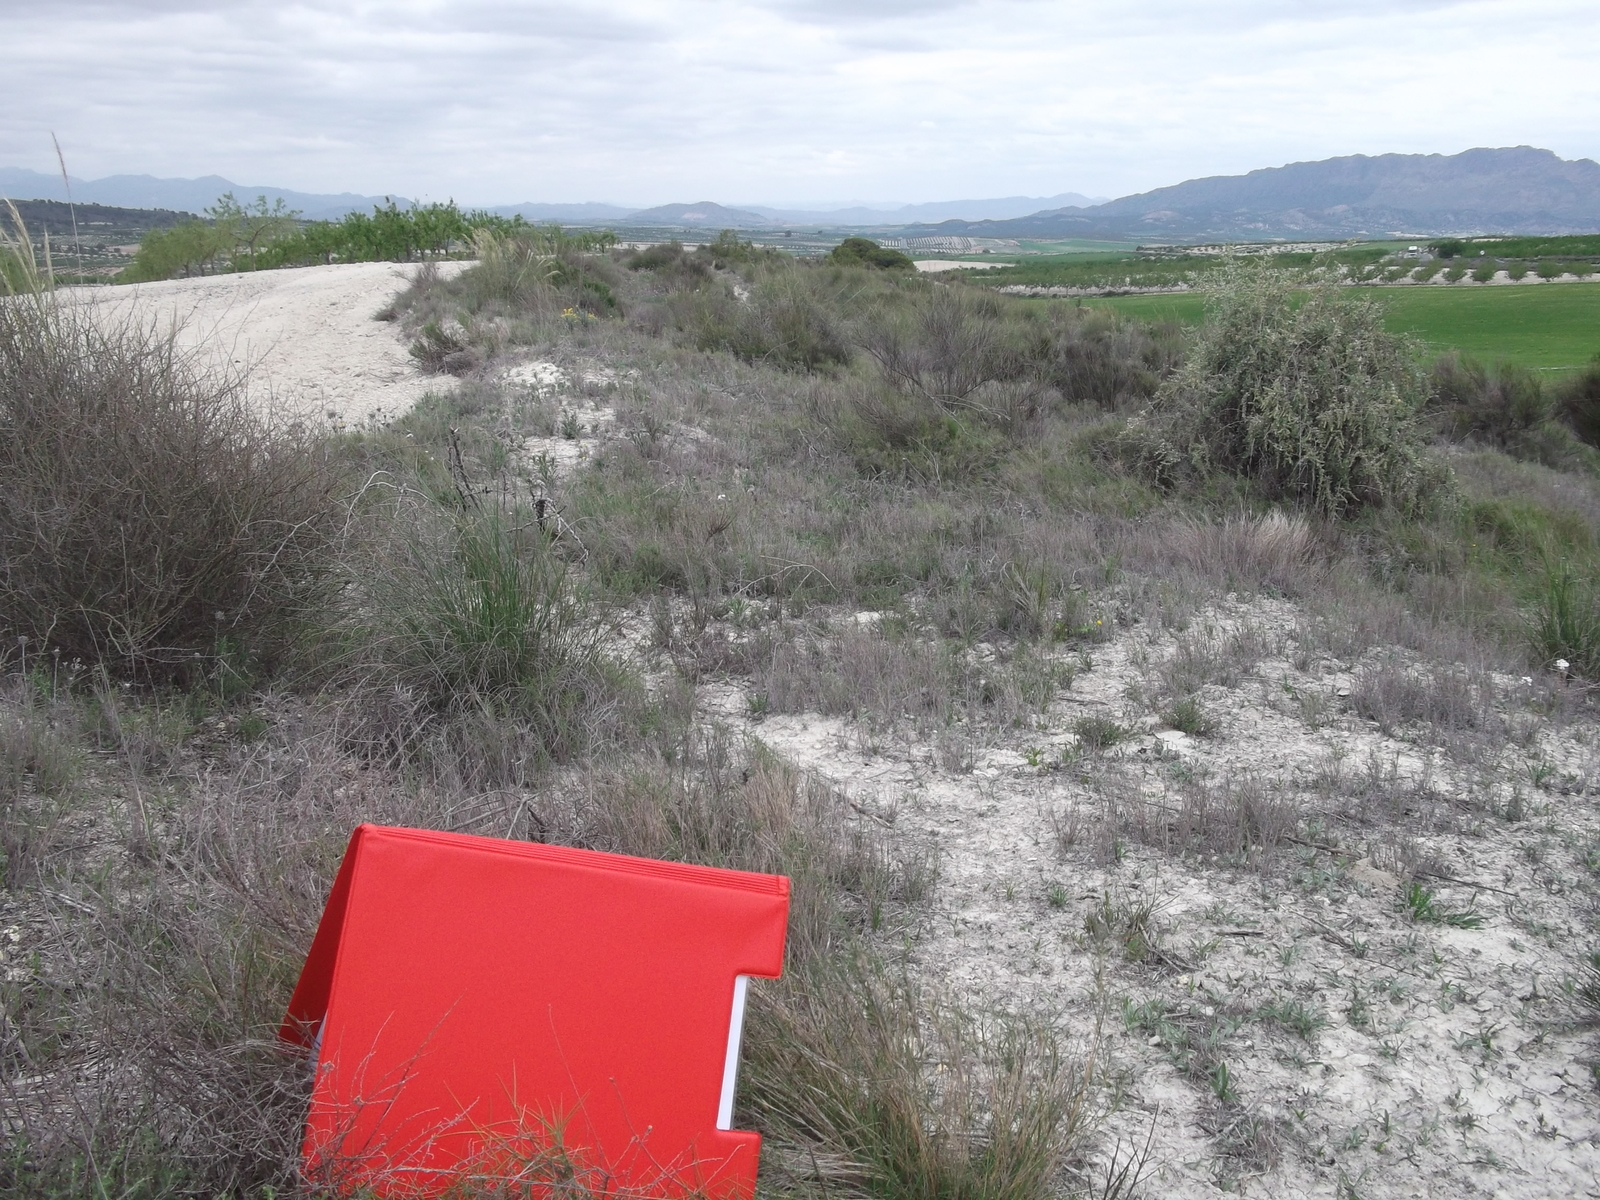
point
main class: Shrubland
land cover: Shrubland without tree cover
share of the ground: 50 - 75 %
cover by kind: shrubs 50 %, herbaceous plants 50 %
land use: Abandoned areas
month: April
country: ES
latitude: 38.1341
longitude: -1.5908
